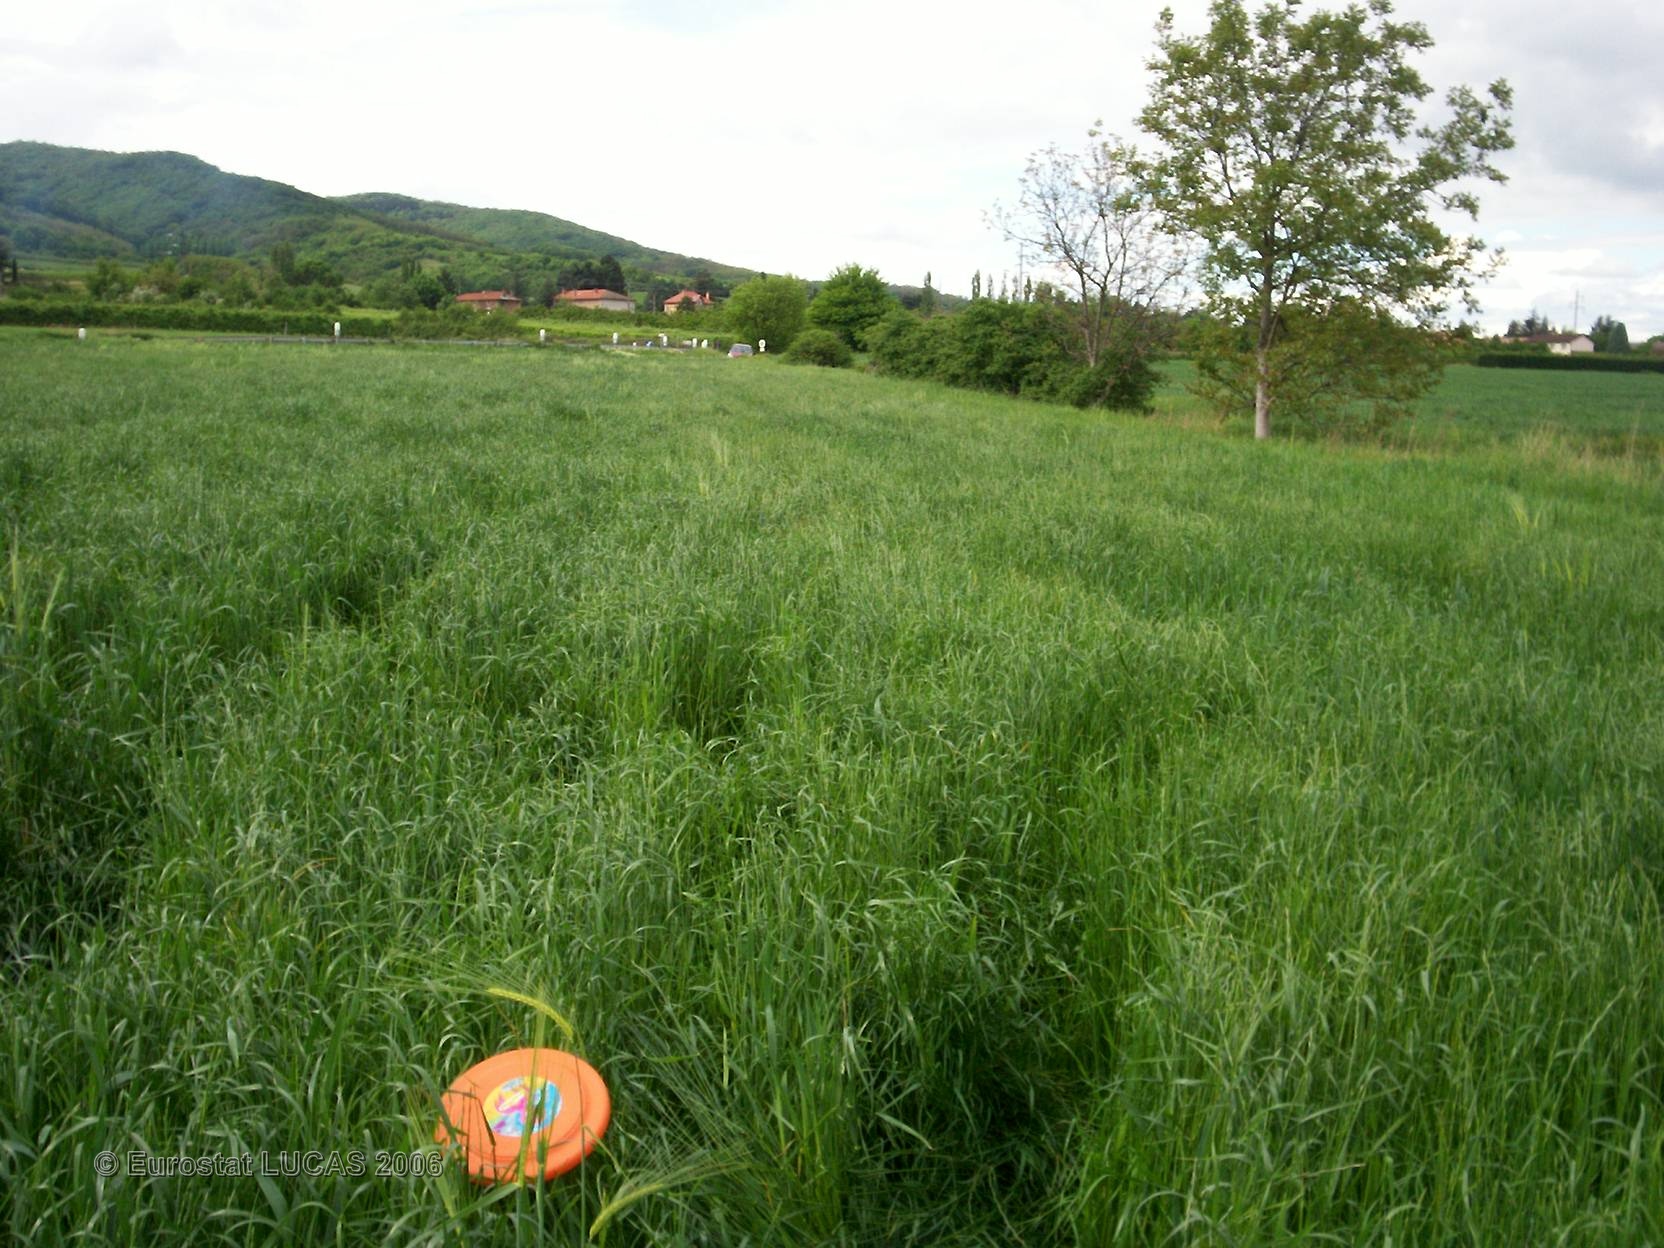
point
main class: Grassland
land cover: Grassland without tree/shrub cover
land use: Agriculture (excluding fallow land and kitchen gardens)
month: May
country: FR
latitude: 45.8811
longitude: 4.7848
